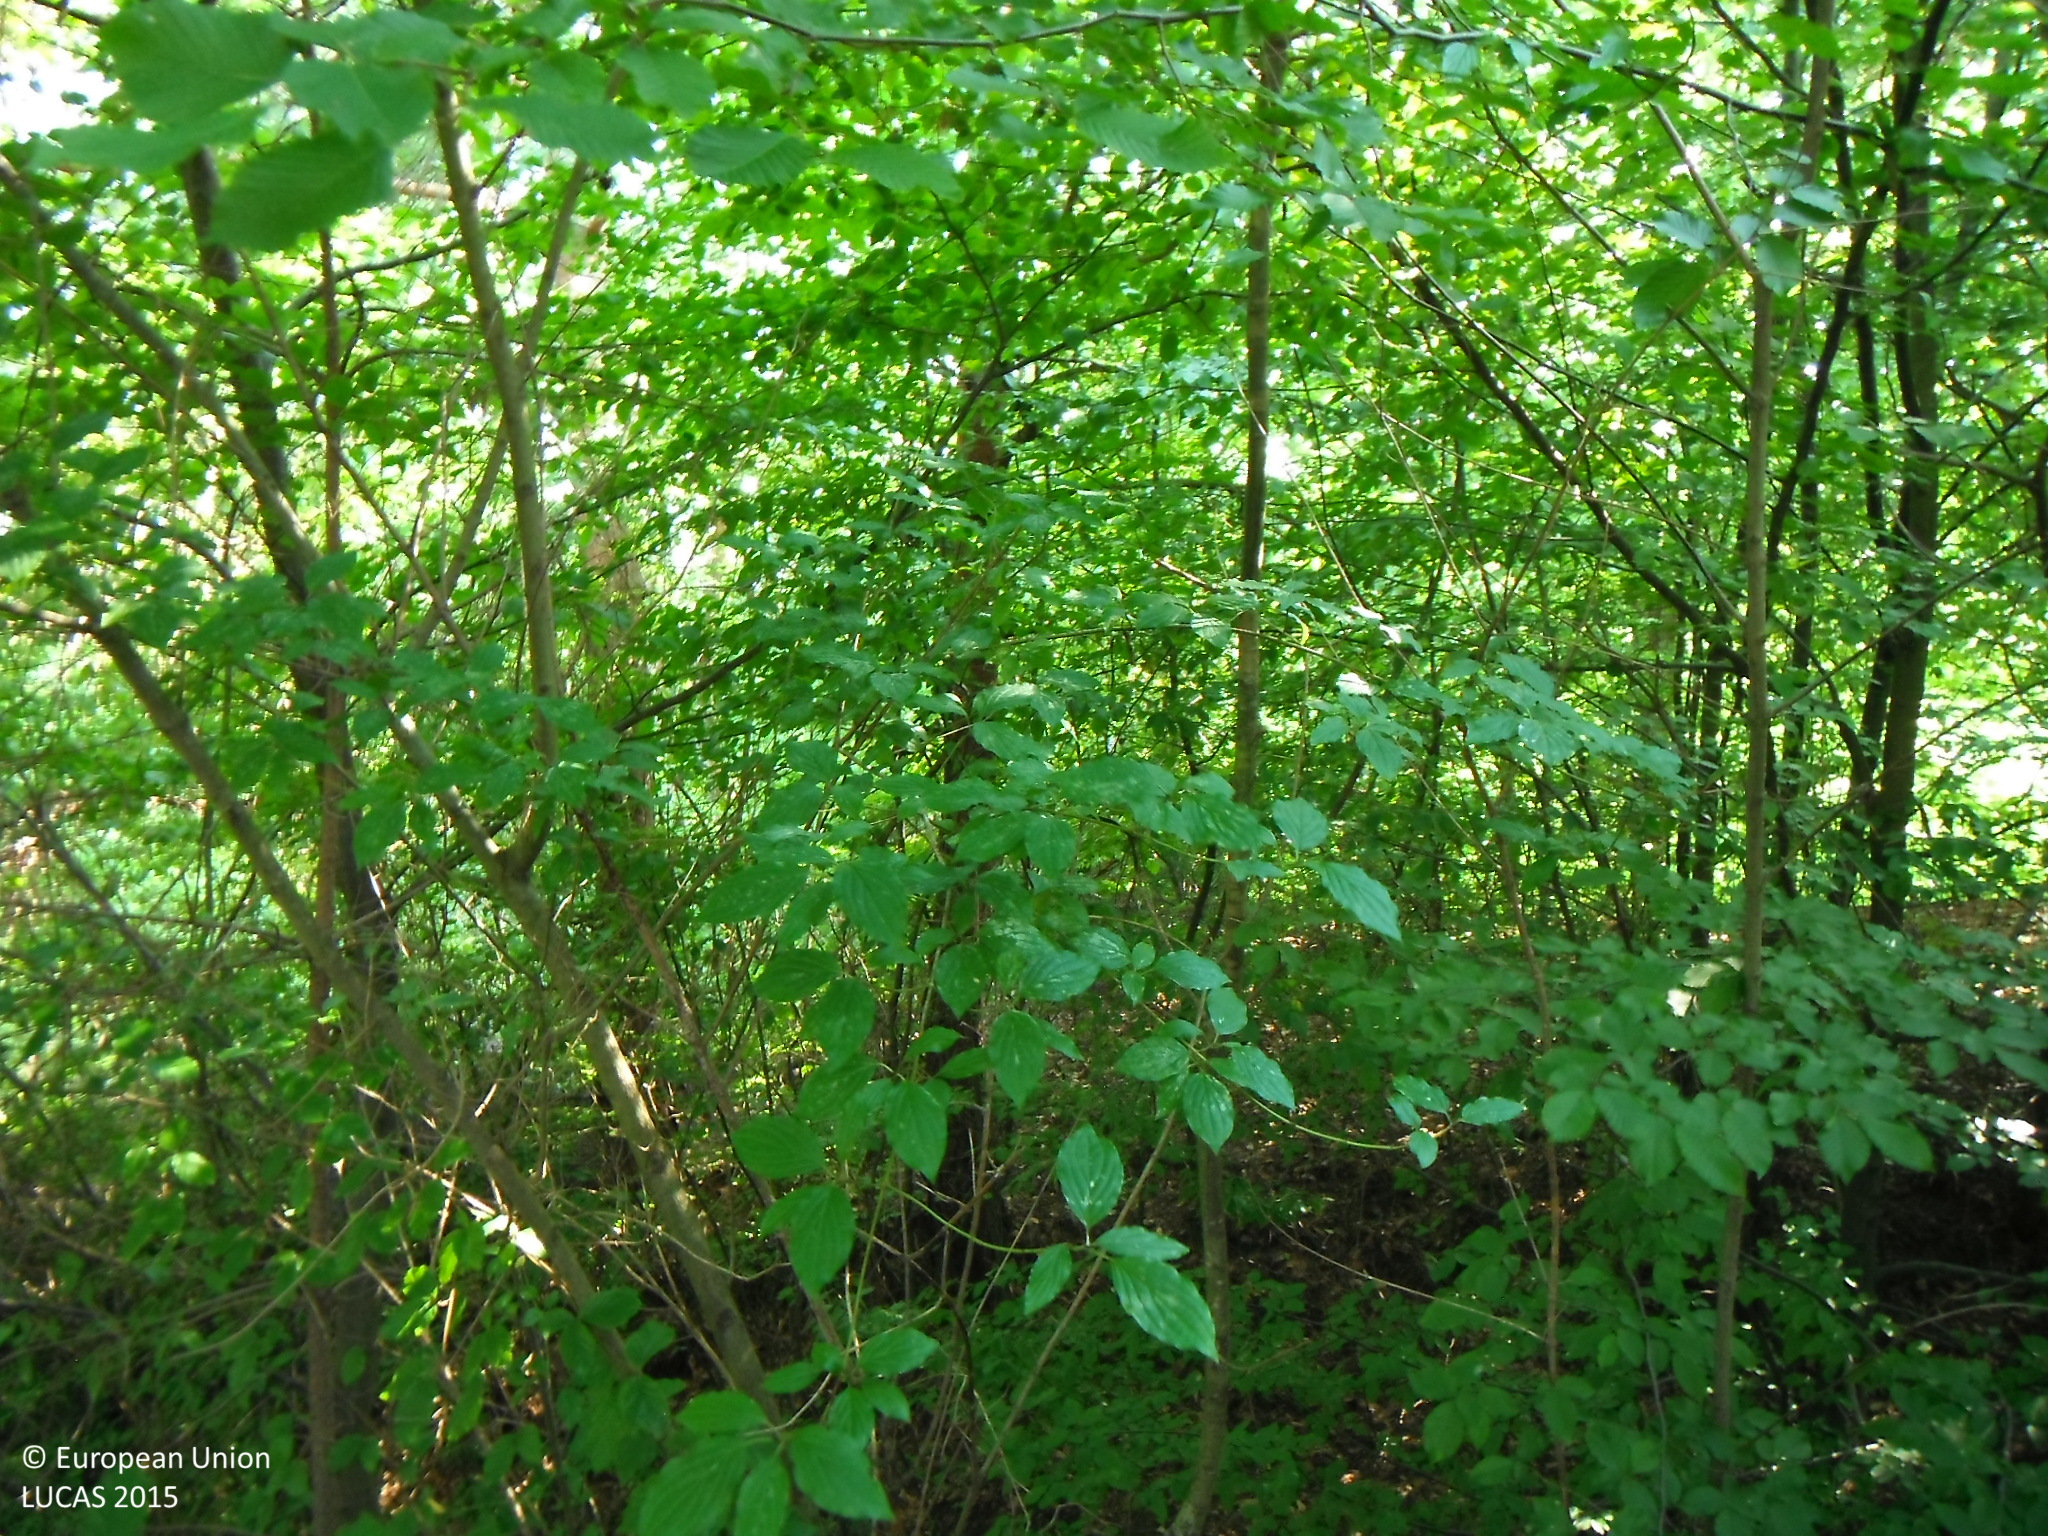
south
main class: Woodland
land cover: Pine dominated mixed woodland
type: hemiboreal forest and nemoral coniferous forest and mixed broadleaved-coniferous forest
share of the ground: > 75 %
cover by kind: coniferous forest trees 60 %, broadleaved forest trees 40 %
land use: Forestry
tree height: > 5 m
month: July
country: SK
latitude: 49.3077
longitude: 21.3390
